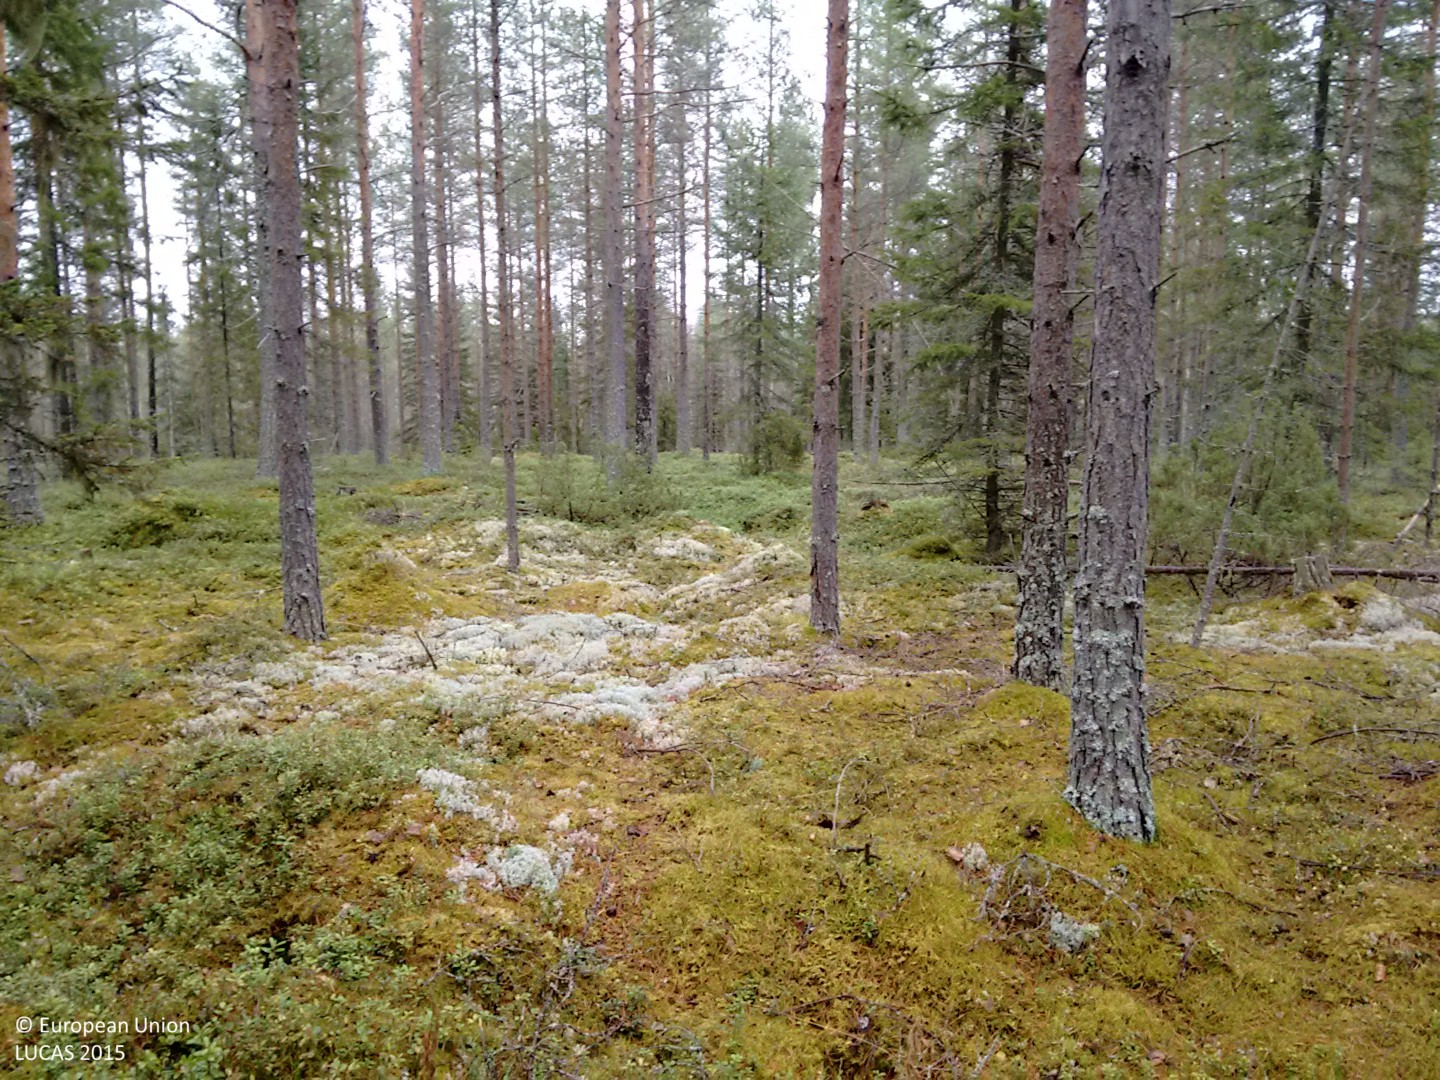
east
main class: Woodland
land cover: Pine dominated coniferous woodland
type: boreal forest
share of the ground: 50 - 75 %
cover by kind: coniferous forest trees 70 %, shrubs 20 %, lichens and mosses 10 %
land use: Forestry
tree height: > 5 m
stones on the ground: > 50 %
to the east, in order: Pine dominated coniferous woodland; Pine dominated mixed woodland; Ditches and canals; Pine dominated mixed woodland; Pine dominated coniferous woodland; Ditches and canals; Pine dominated coniferous woodland; Ditches and canals; Pine dominated coniferous woodland; Ditches and canals; Pine dominated coniferous woodland; Ditches and canals; Pine dominated coniferous woodland; Pine dominated mixed woodland
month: October
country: FI
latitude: 64.5248
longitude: 25.2325
